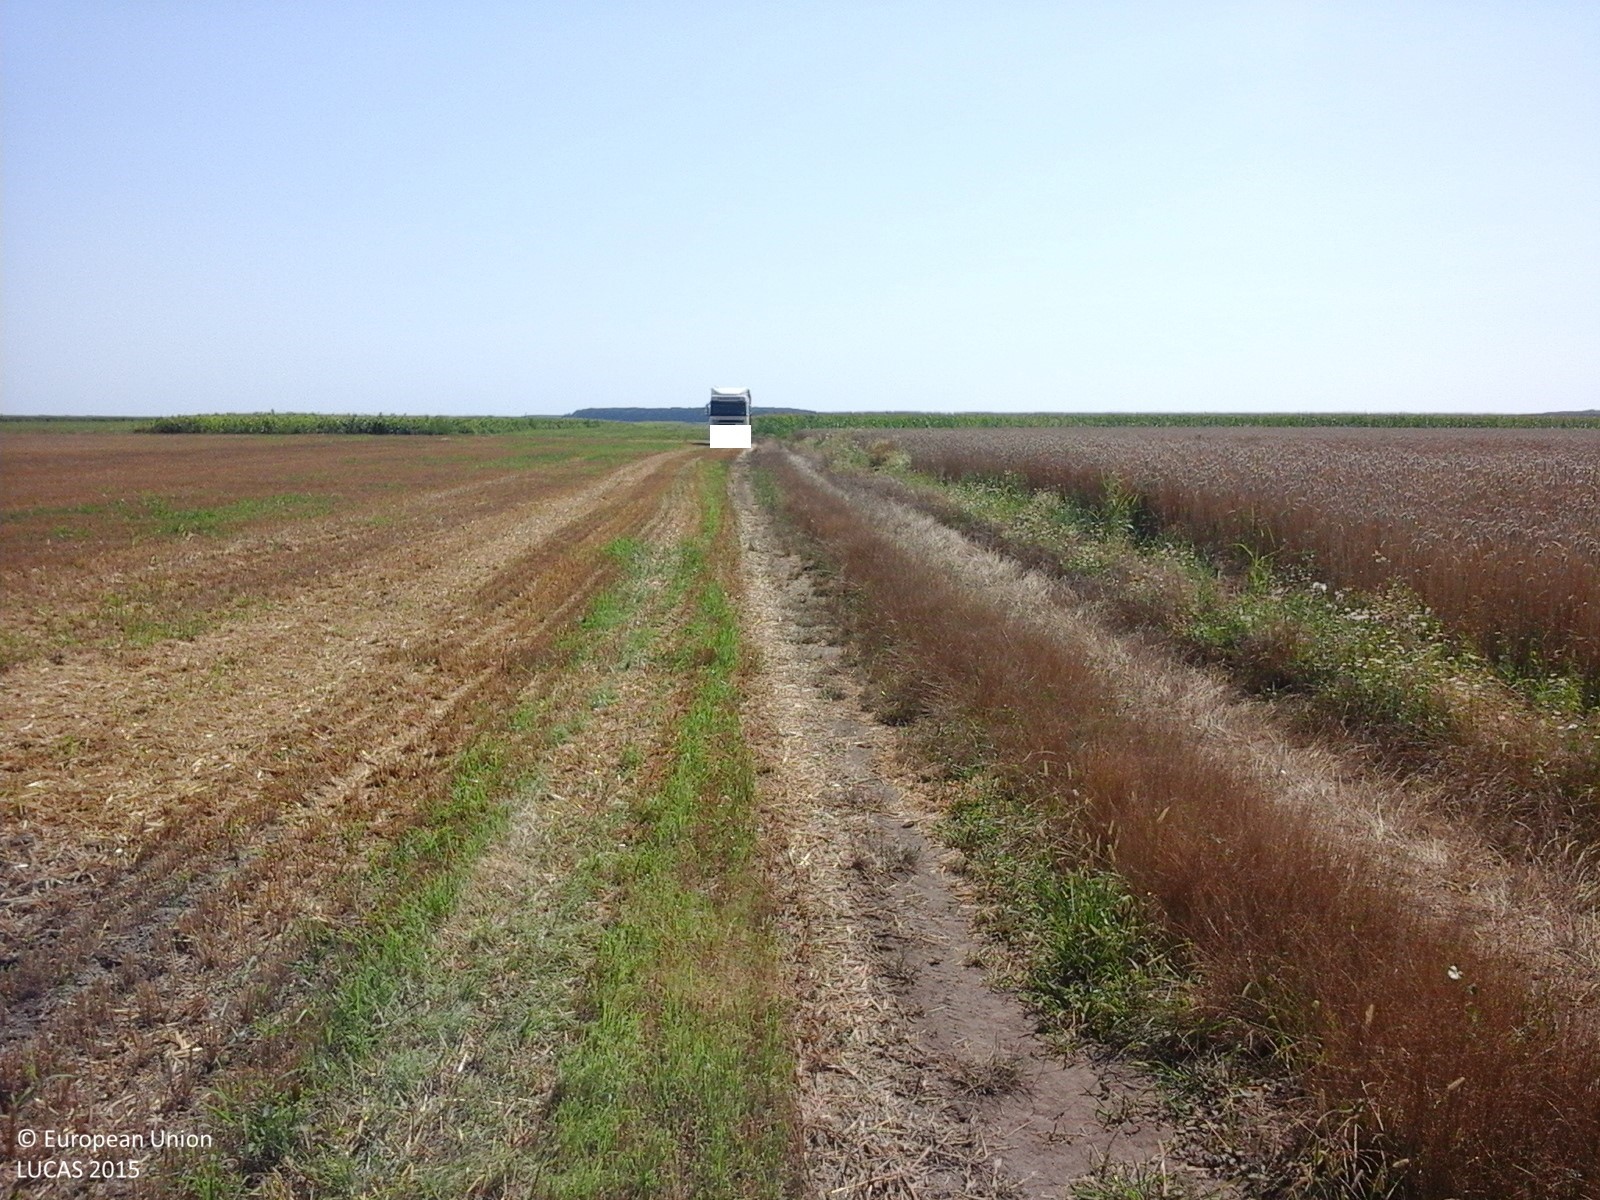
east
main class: Cropland
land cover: Common wheat
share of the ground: > 75 %
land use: Agriculture (excluding fallow land and kitchen gardens)
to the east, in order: Common wheat; Maize
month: July
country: RO
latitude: 44.4187
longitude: 26.4794
